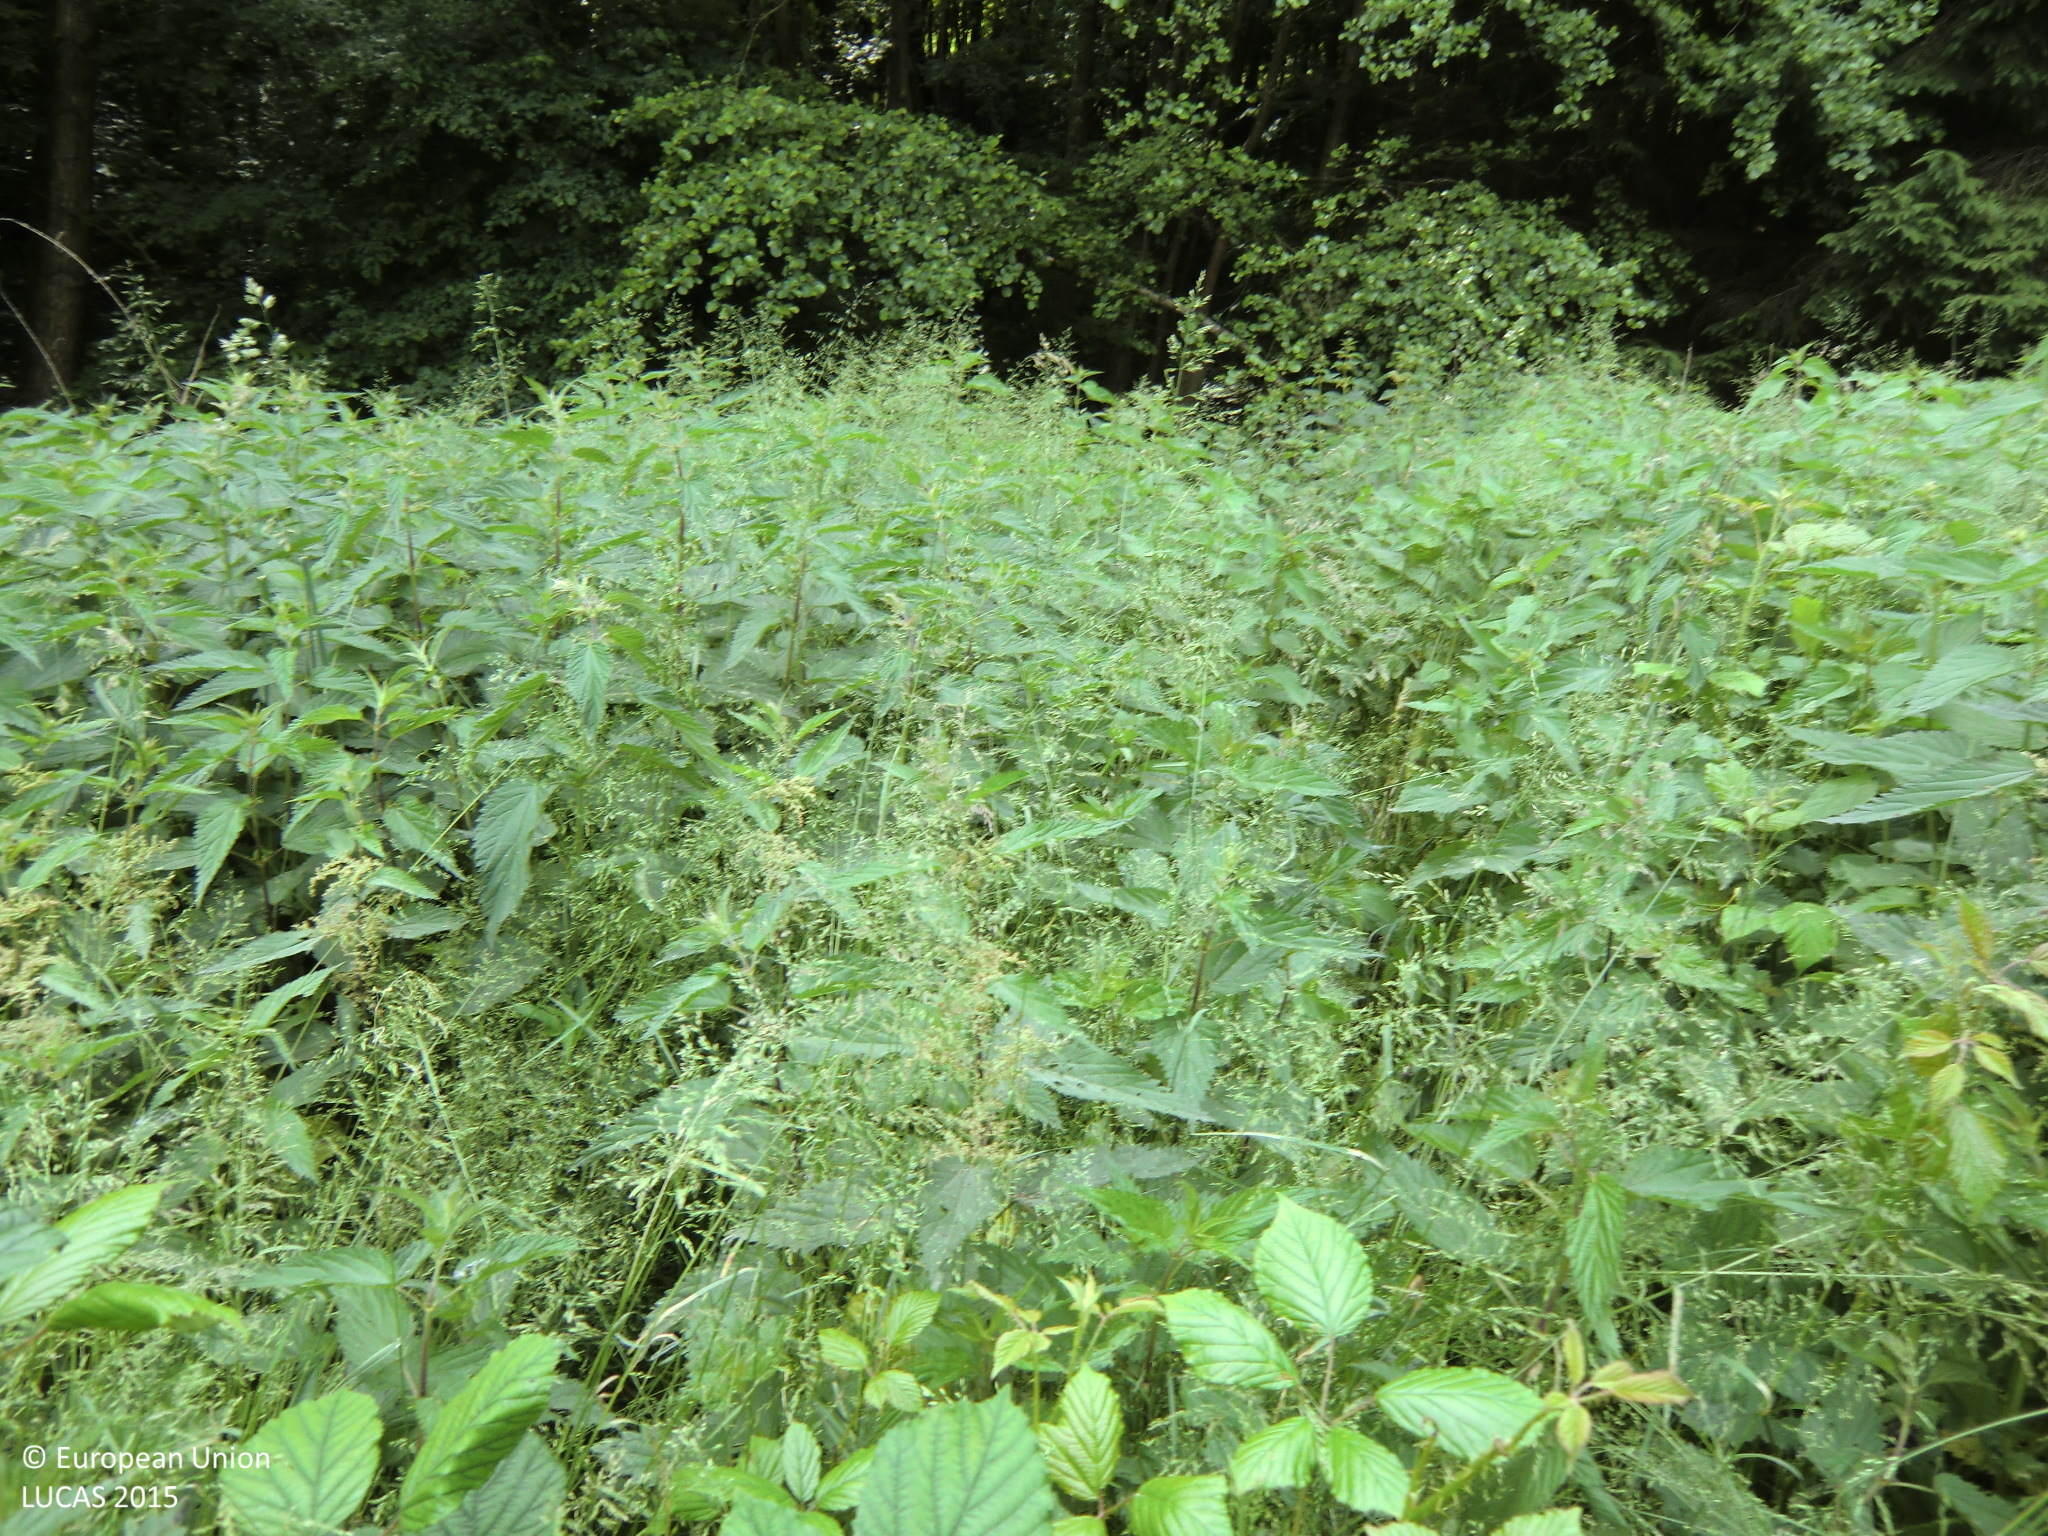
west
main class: Grassland
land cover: Spontaneously vegetated surfaces
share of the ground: > 75 %
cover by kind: herbaceous plants 100 %
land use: Agriculture (excluding fallow land and kitchen gardens)
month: May
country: AT
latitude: 48.1994
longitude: 15.0197
